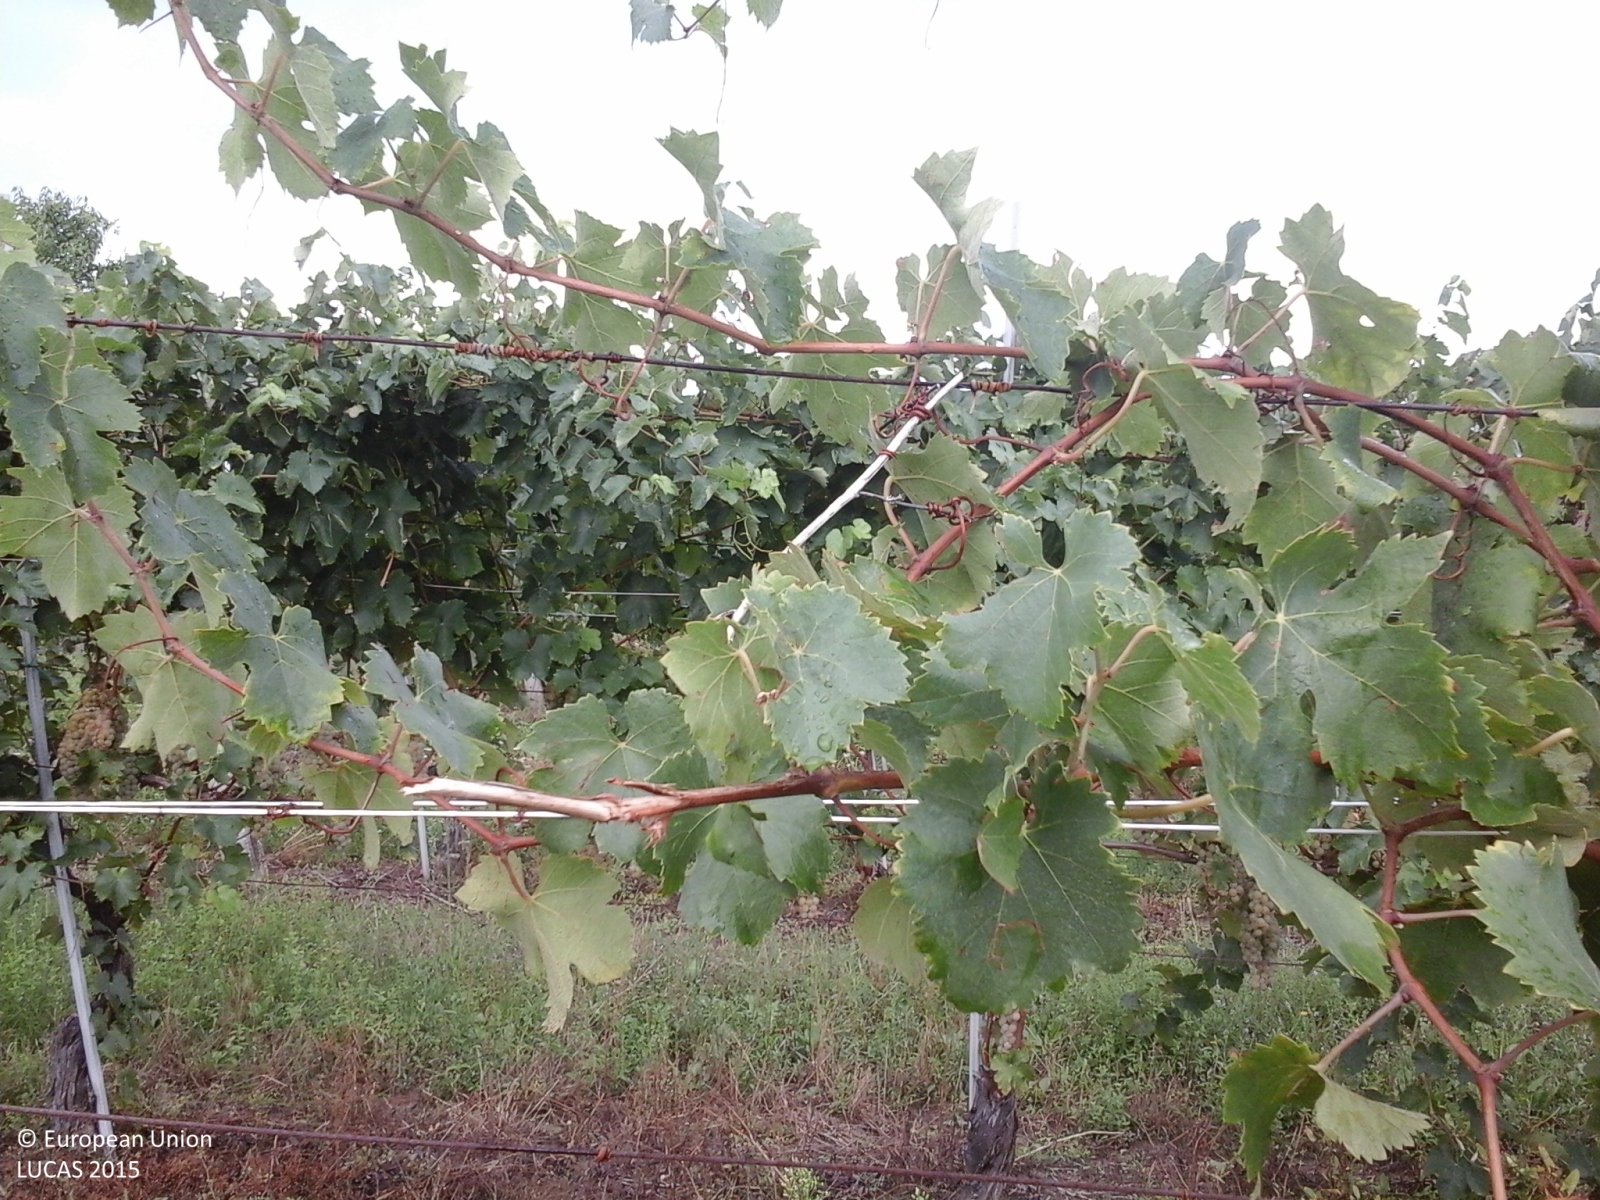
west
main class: Cropland
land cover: Vineyards
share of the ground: 50 - 75 %
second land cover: Spontaneously vegetated surfaces
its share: > 75 %
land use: Agriculture (excluding fallow land and kitchen gardens)
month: August
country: IT
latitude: 43.4536
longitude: 13.1680
